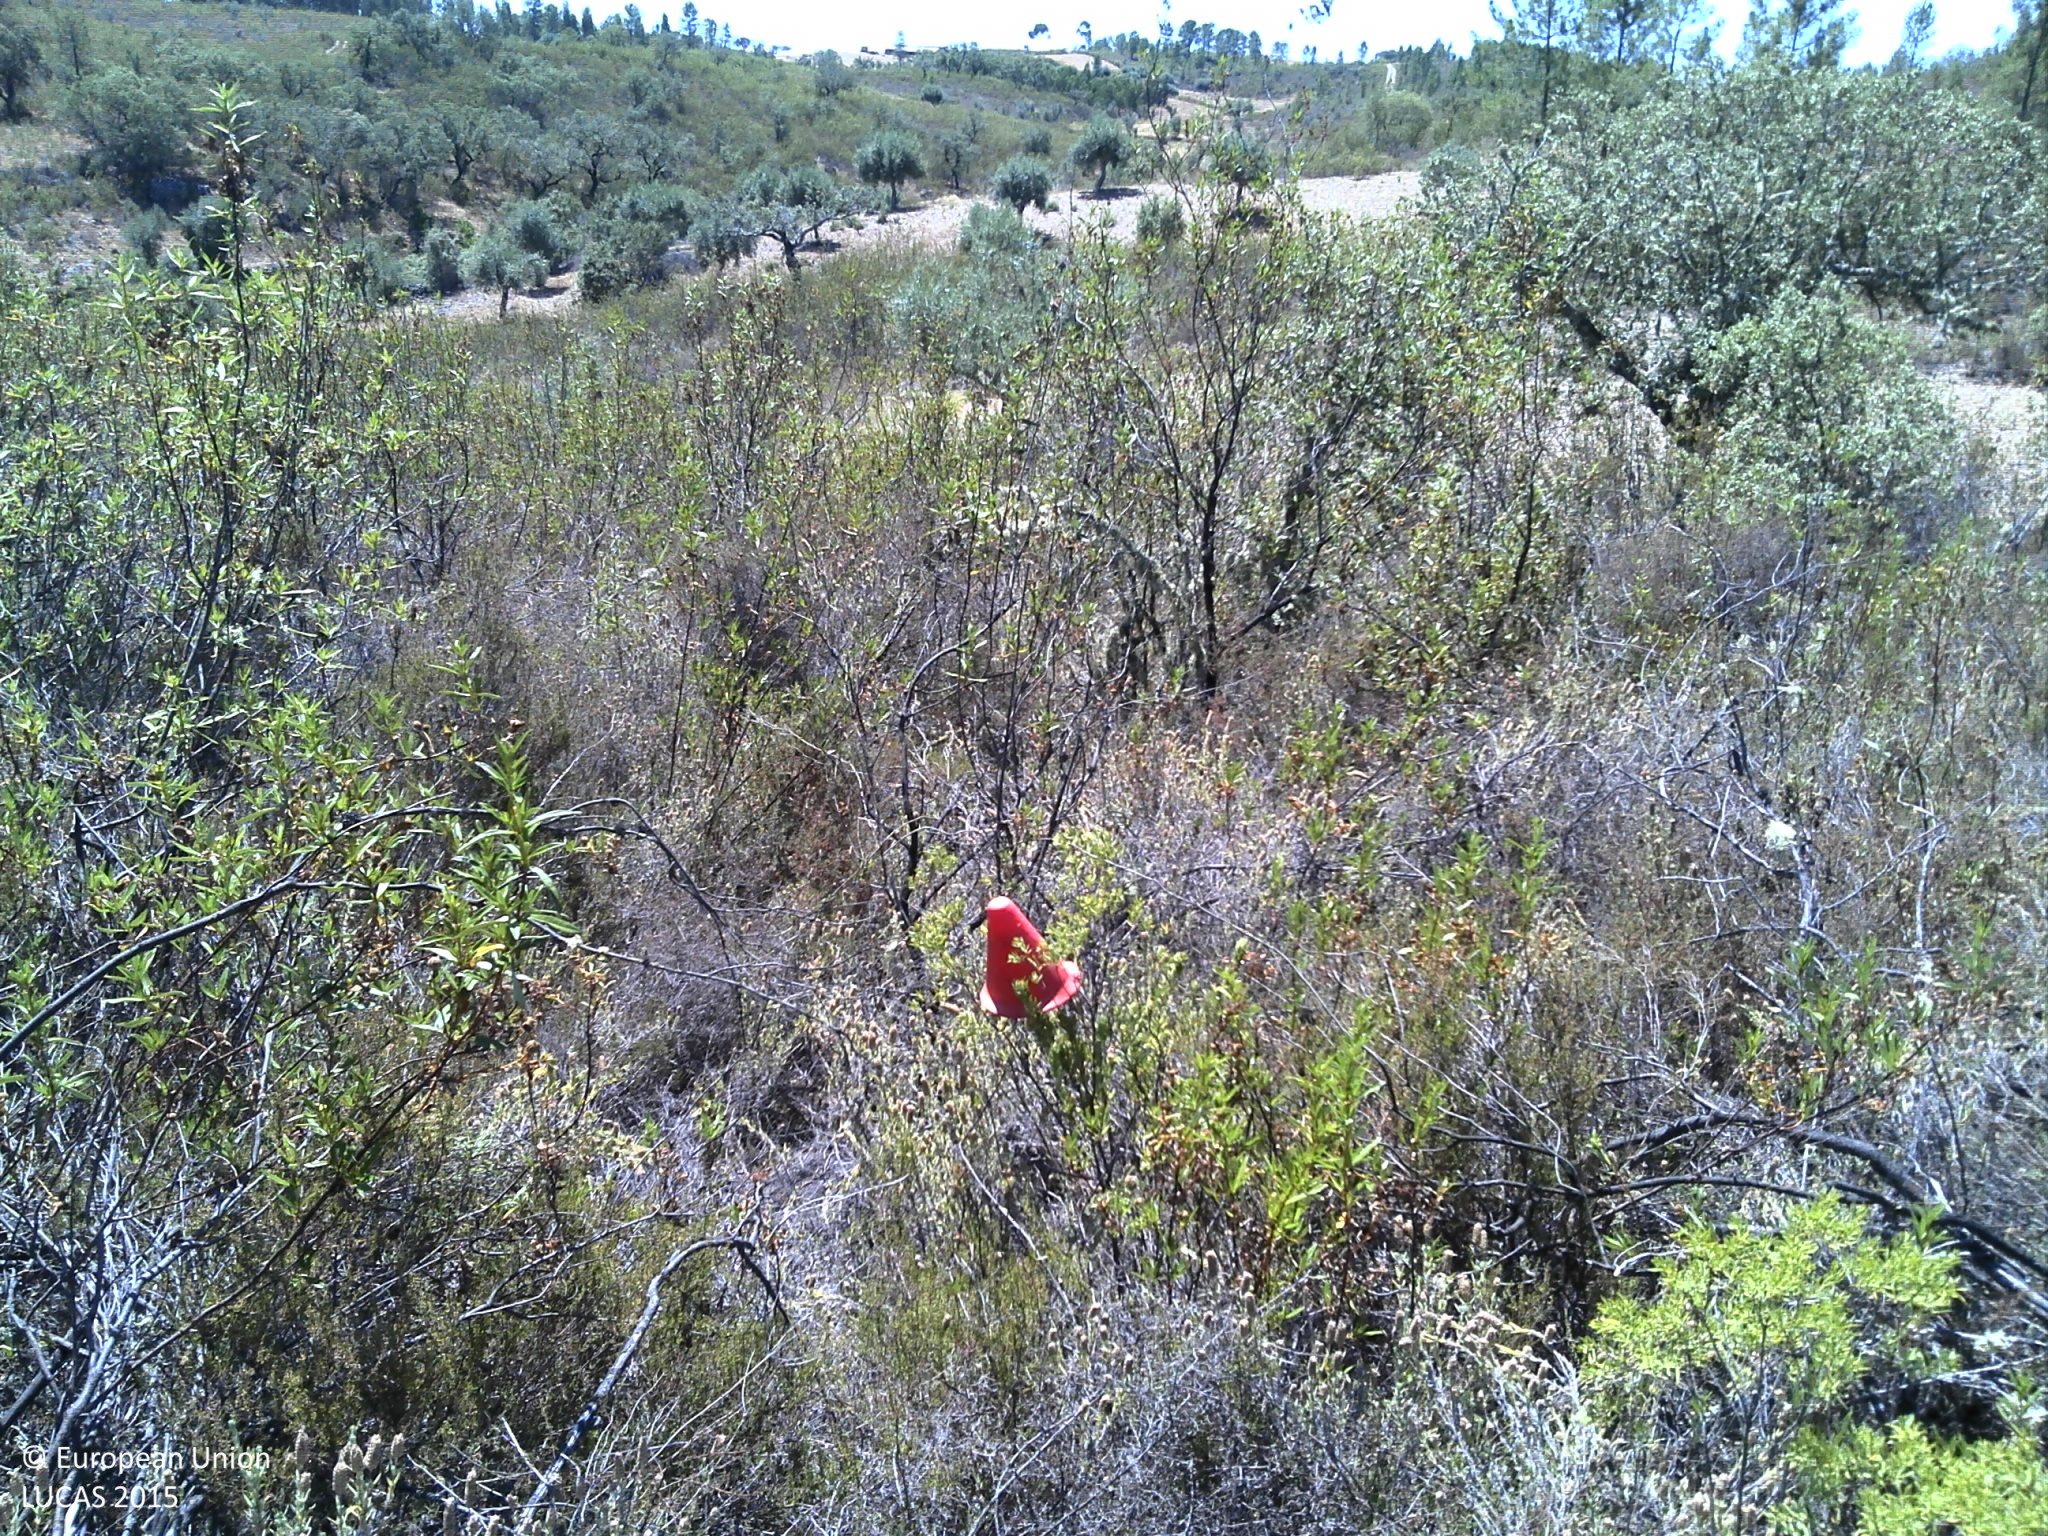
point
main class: Shrubland
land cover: Shrubland with sparse tree cover
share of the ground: > 75 %
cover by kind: shrubs 95 %, broadleaved forest trees 5 %
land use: Semi-natural and natural areas not in use
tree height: < 5 m
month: July
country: PT
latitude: 39.6753
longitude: -7.8132
